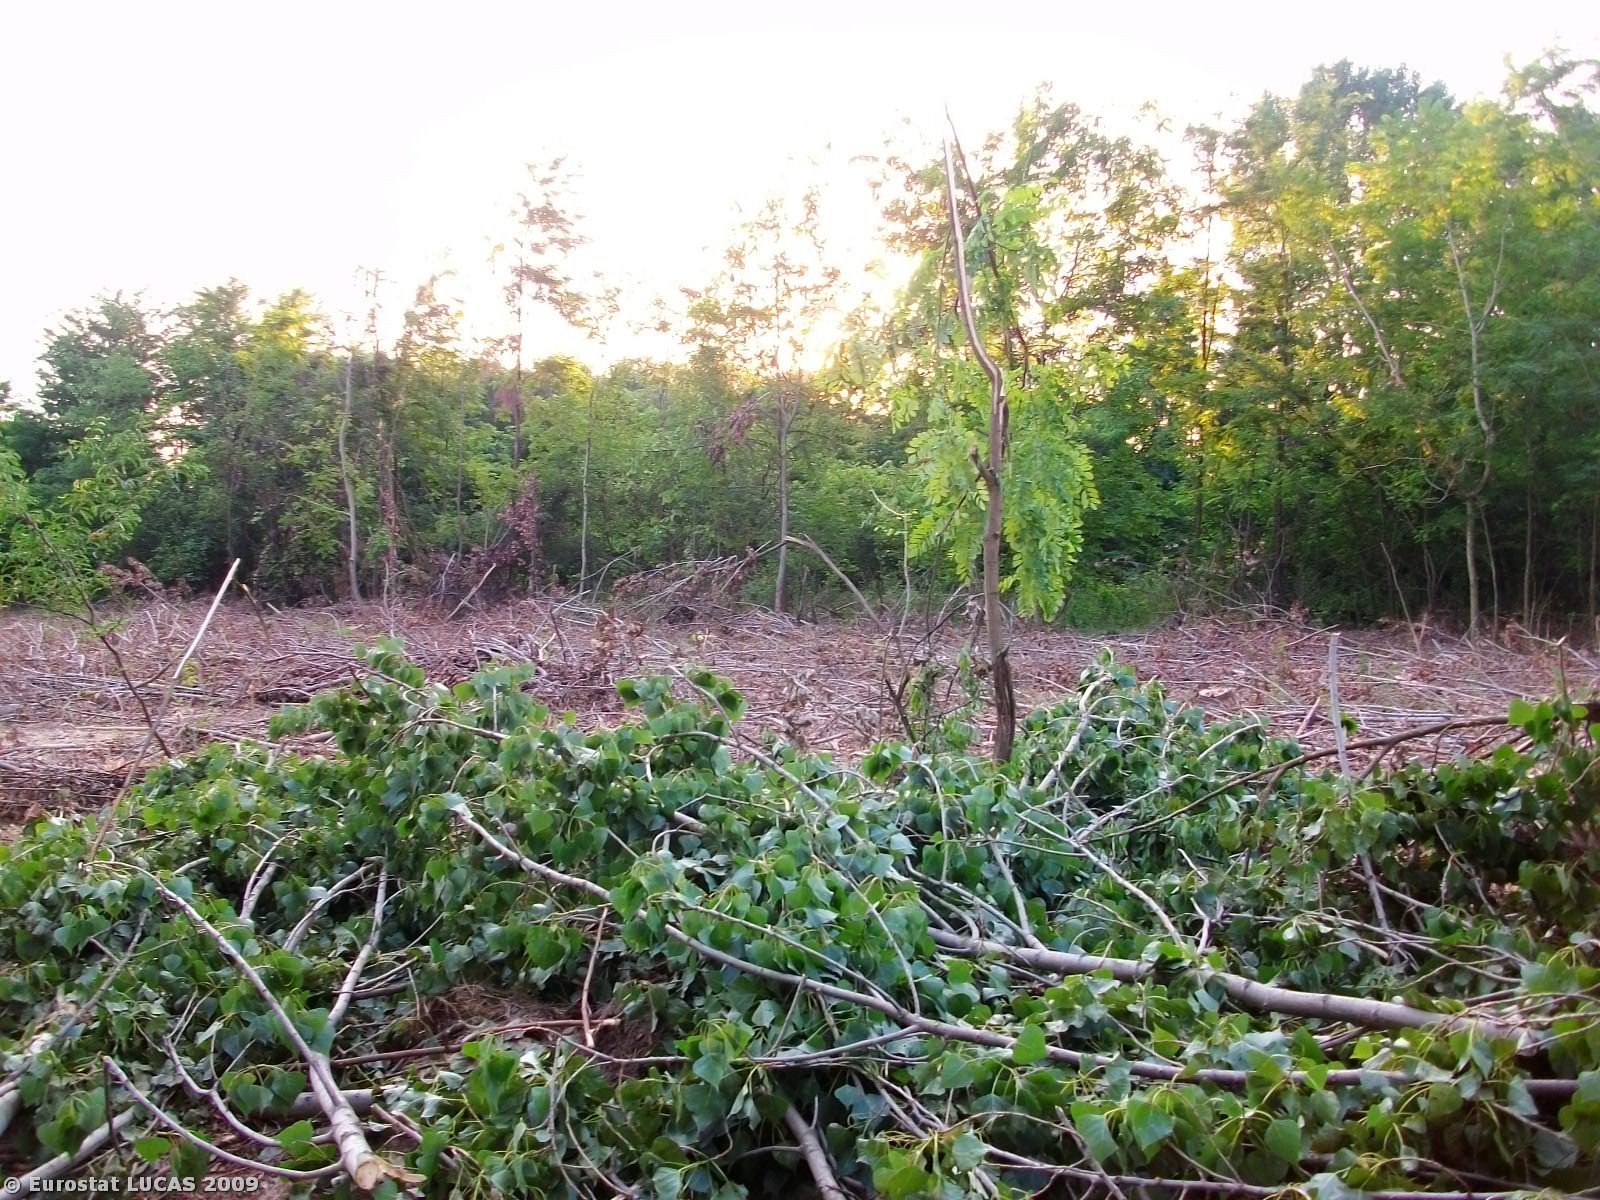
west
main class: Woodland
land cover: Broadleaved woodland
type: non-riverine alder, birch or aspen forest
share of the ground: > 75 %
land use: Forestry
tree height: > 5 m
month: June
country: GR
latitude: 41.0765
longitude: 23.5770
